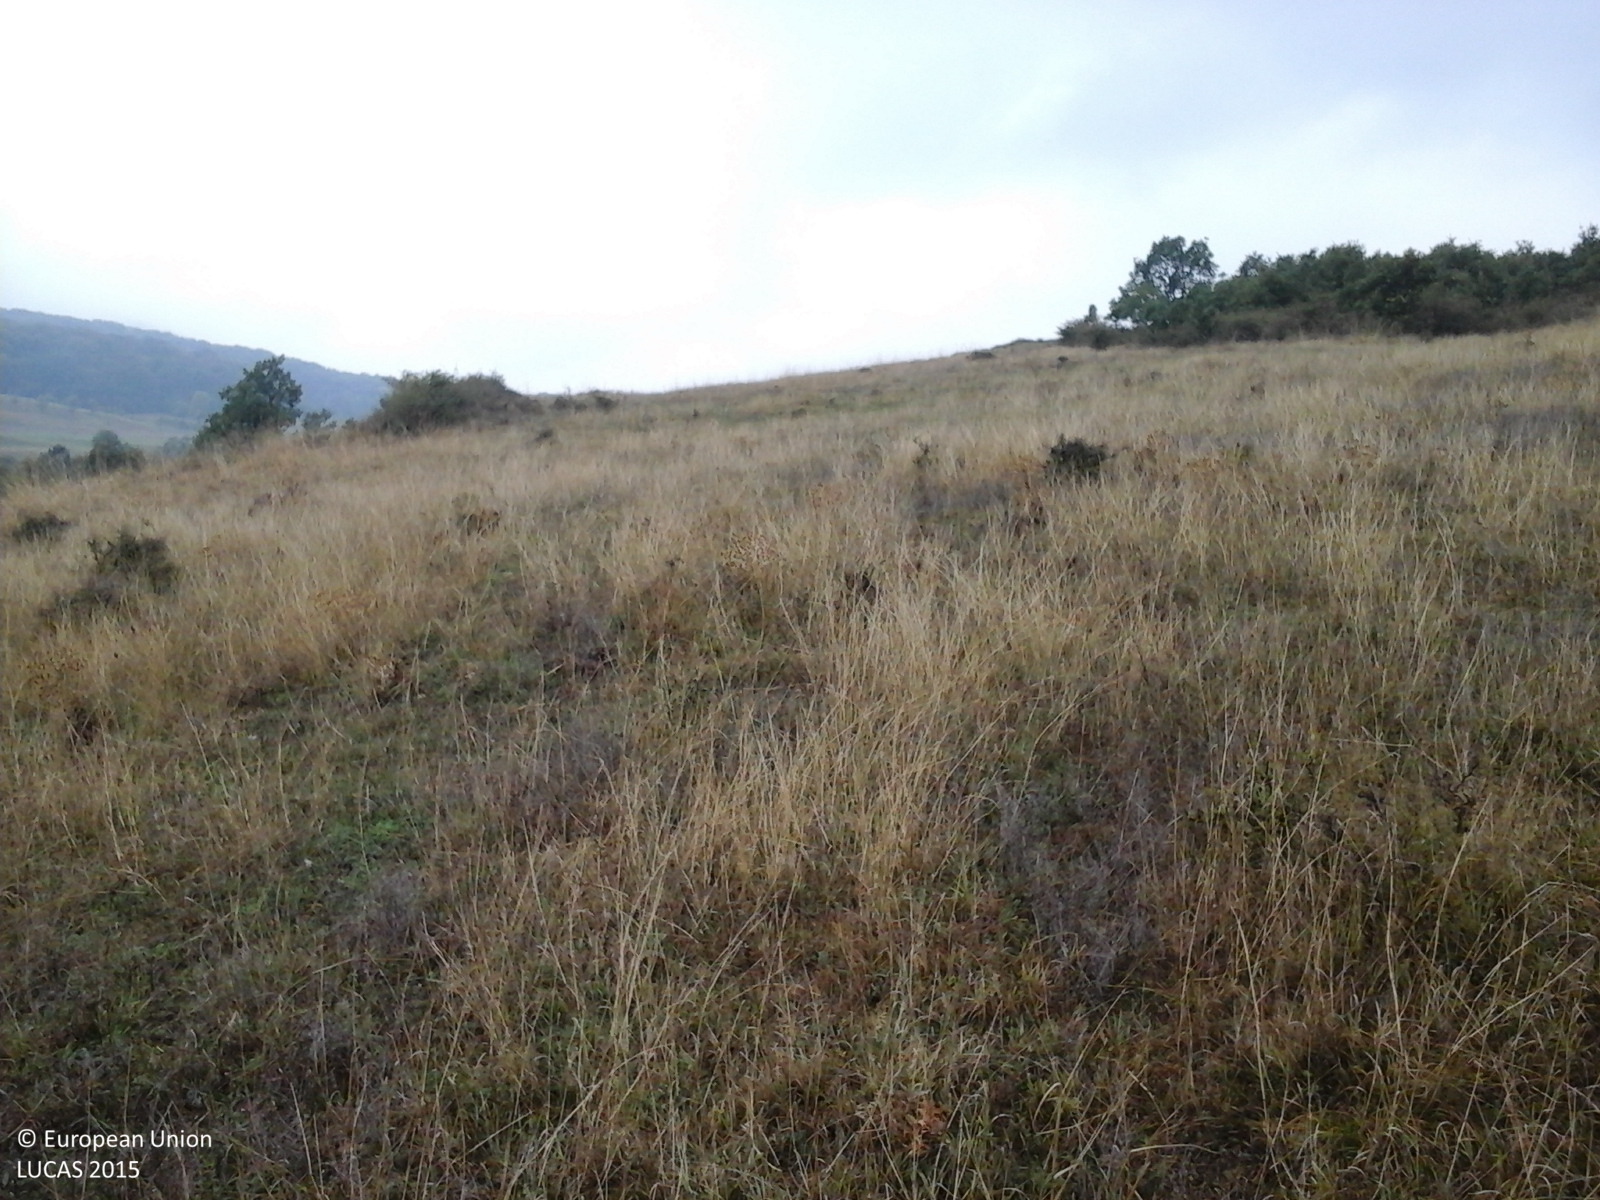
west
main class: Grassland
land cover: Grassland with sparse tree/shrub cover
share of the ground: > 75 %
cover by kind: herbaceous plants 85 %, shrubs 10 %, broadleaved forest trees 5 %
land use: Agriculture (excluding fallow land and kitchen gardens)
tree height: < 5 m
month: September
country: RO
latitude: 45.8971
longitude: 22.8777
